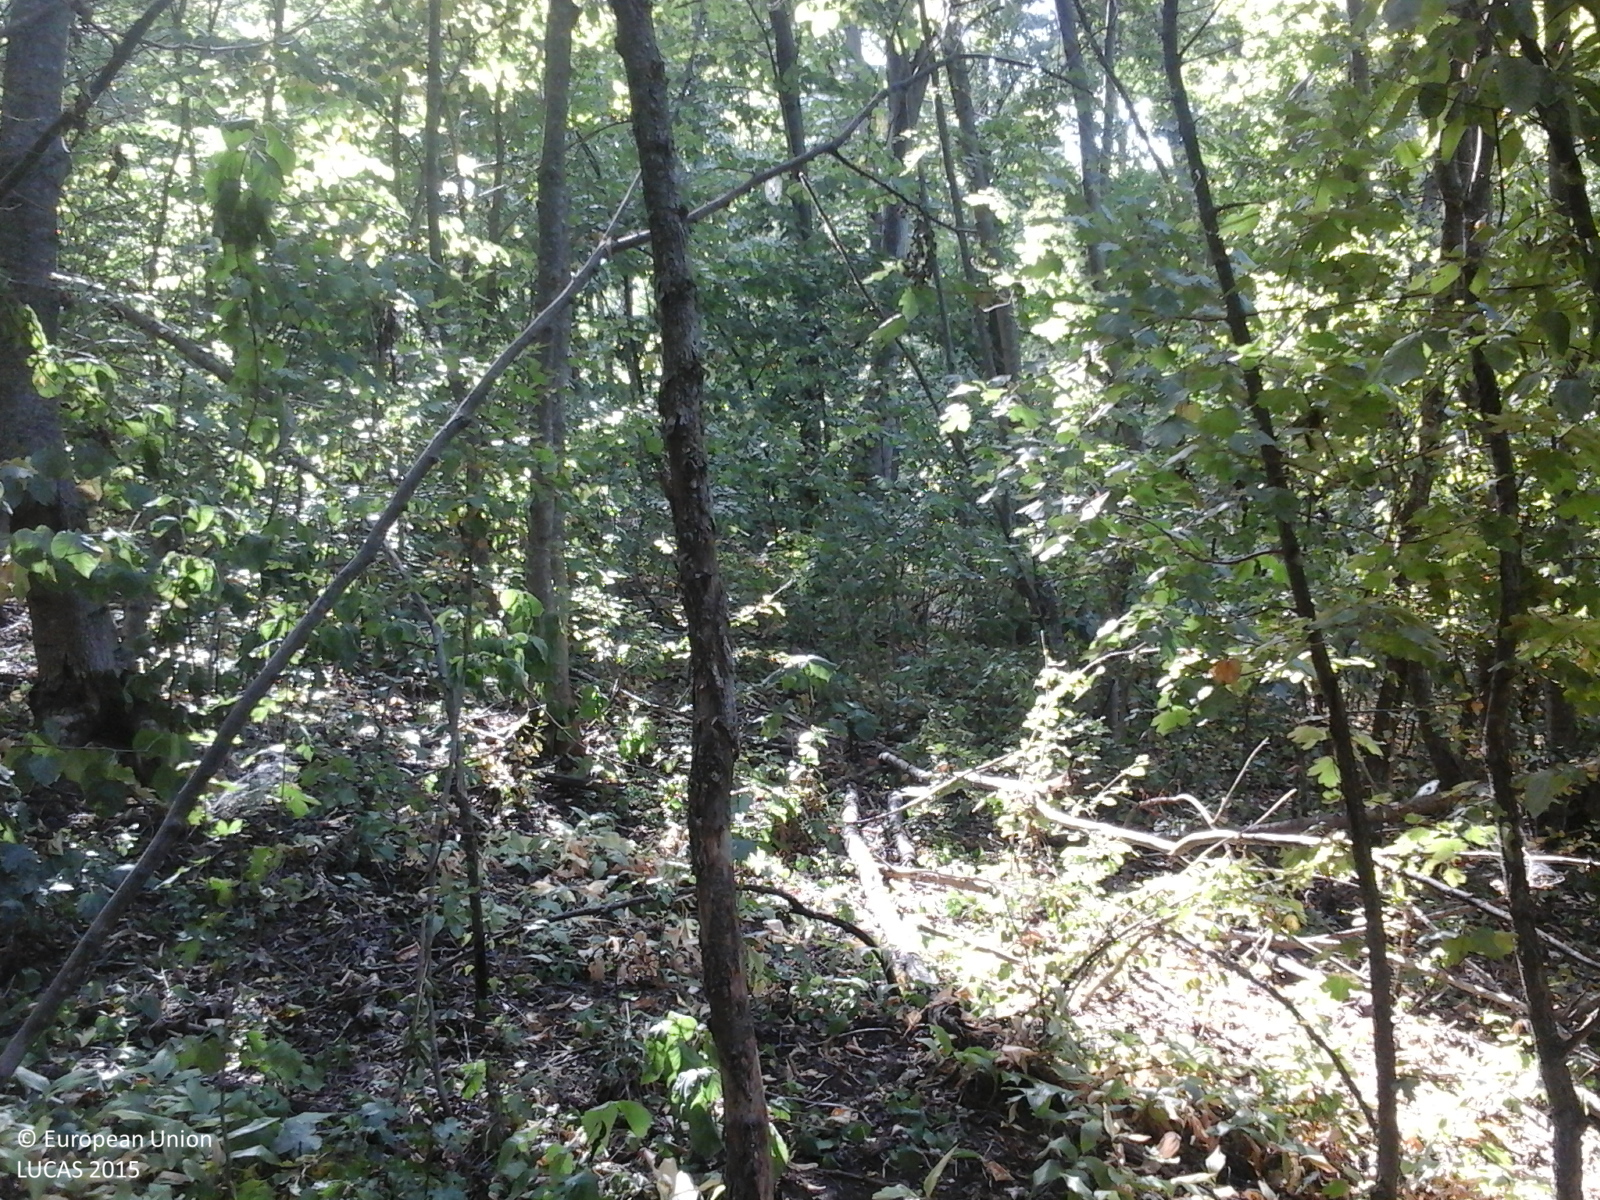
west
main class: Woodland
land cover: Broadleaved woodland
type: acidophilous oak and oak-birch forest
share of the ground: > 75 %
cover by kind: broadleaved forest trees 100 %
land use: Forestry
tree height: > 5 m
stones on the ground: < 10 %
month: July
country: RO
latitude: 46.2484
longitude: 27.8771
